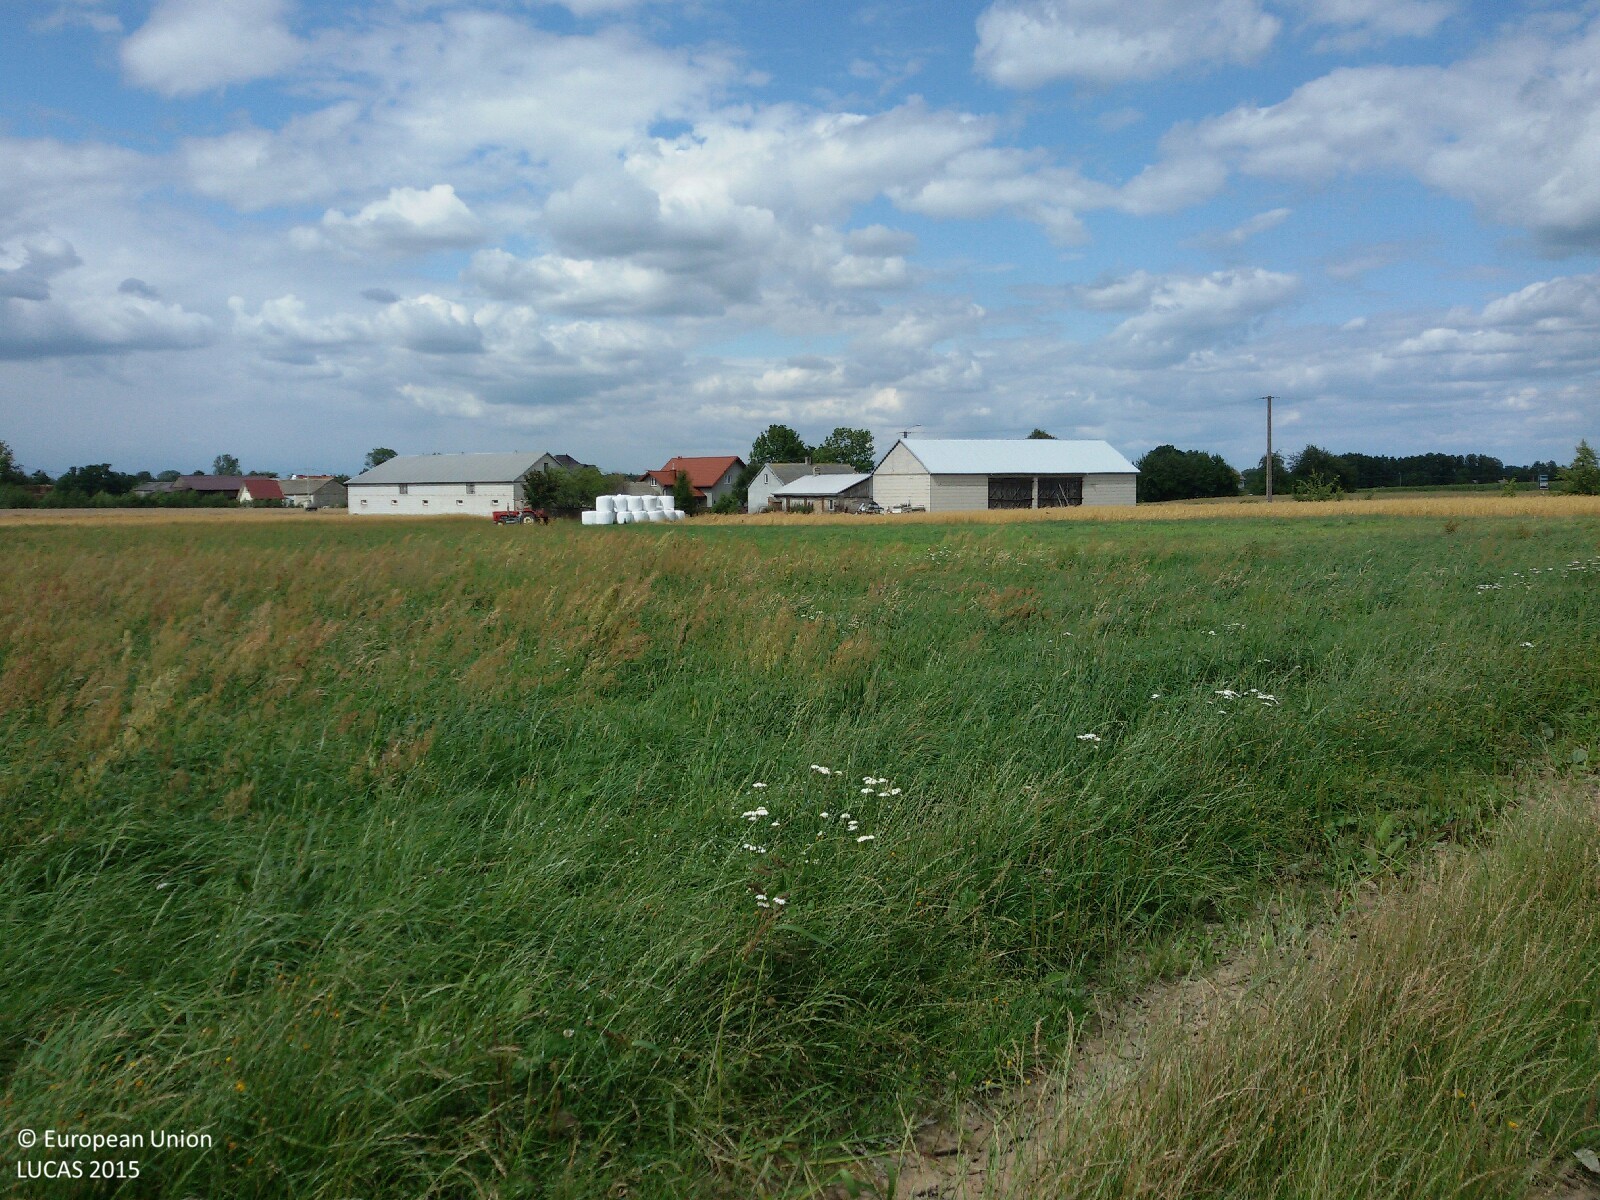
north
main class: Cropland
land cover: Maize
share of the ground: > 75 %
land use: Agriculture (excluding fallow land and kitchen gardens)
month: July
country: PL
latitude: 52.0447
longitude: 21.7629
